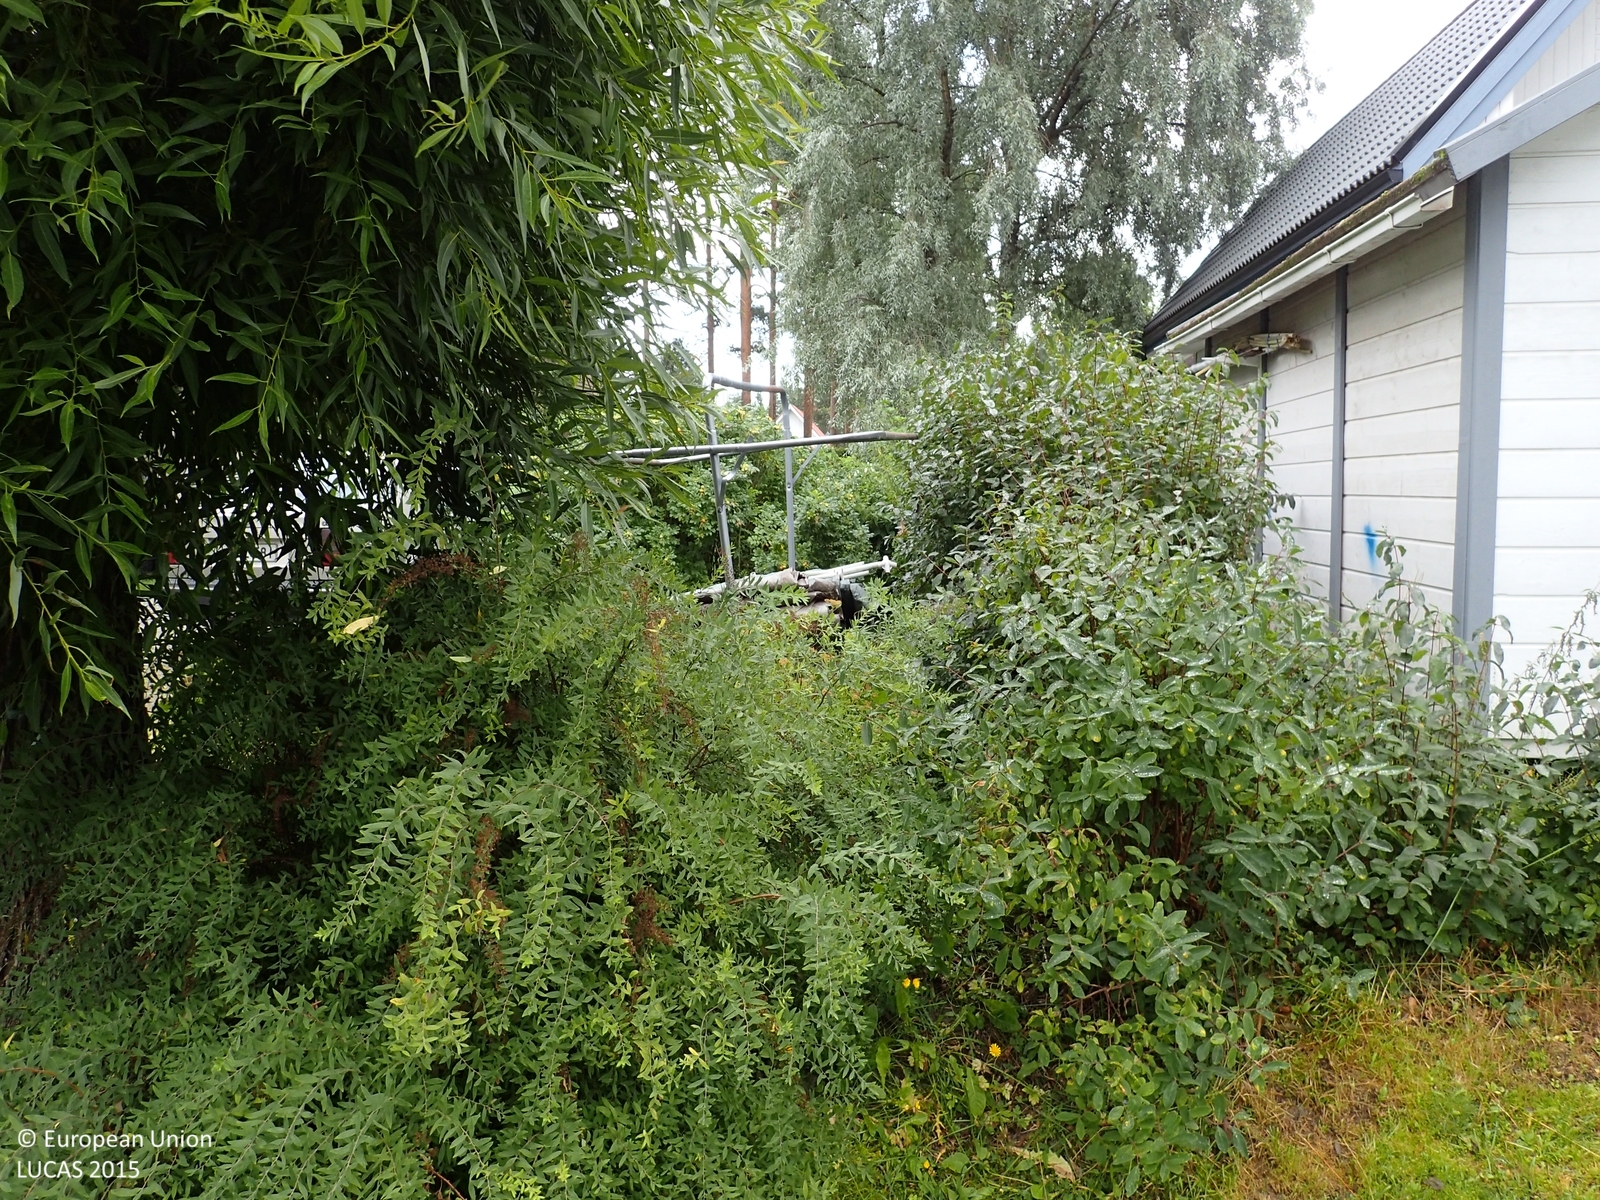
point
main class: Woodland
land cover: Broadleaved woodland
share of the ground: > 75 %
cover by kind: broadleaved forest trees 85 %, herbaceous plants 15 %
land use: Residential
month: August
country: FI
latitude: 62.7797
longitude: 22.7752
